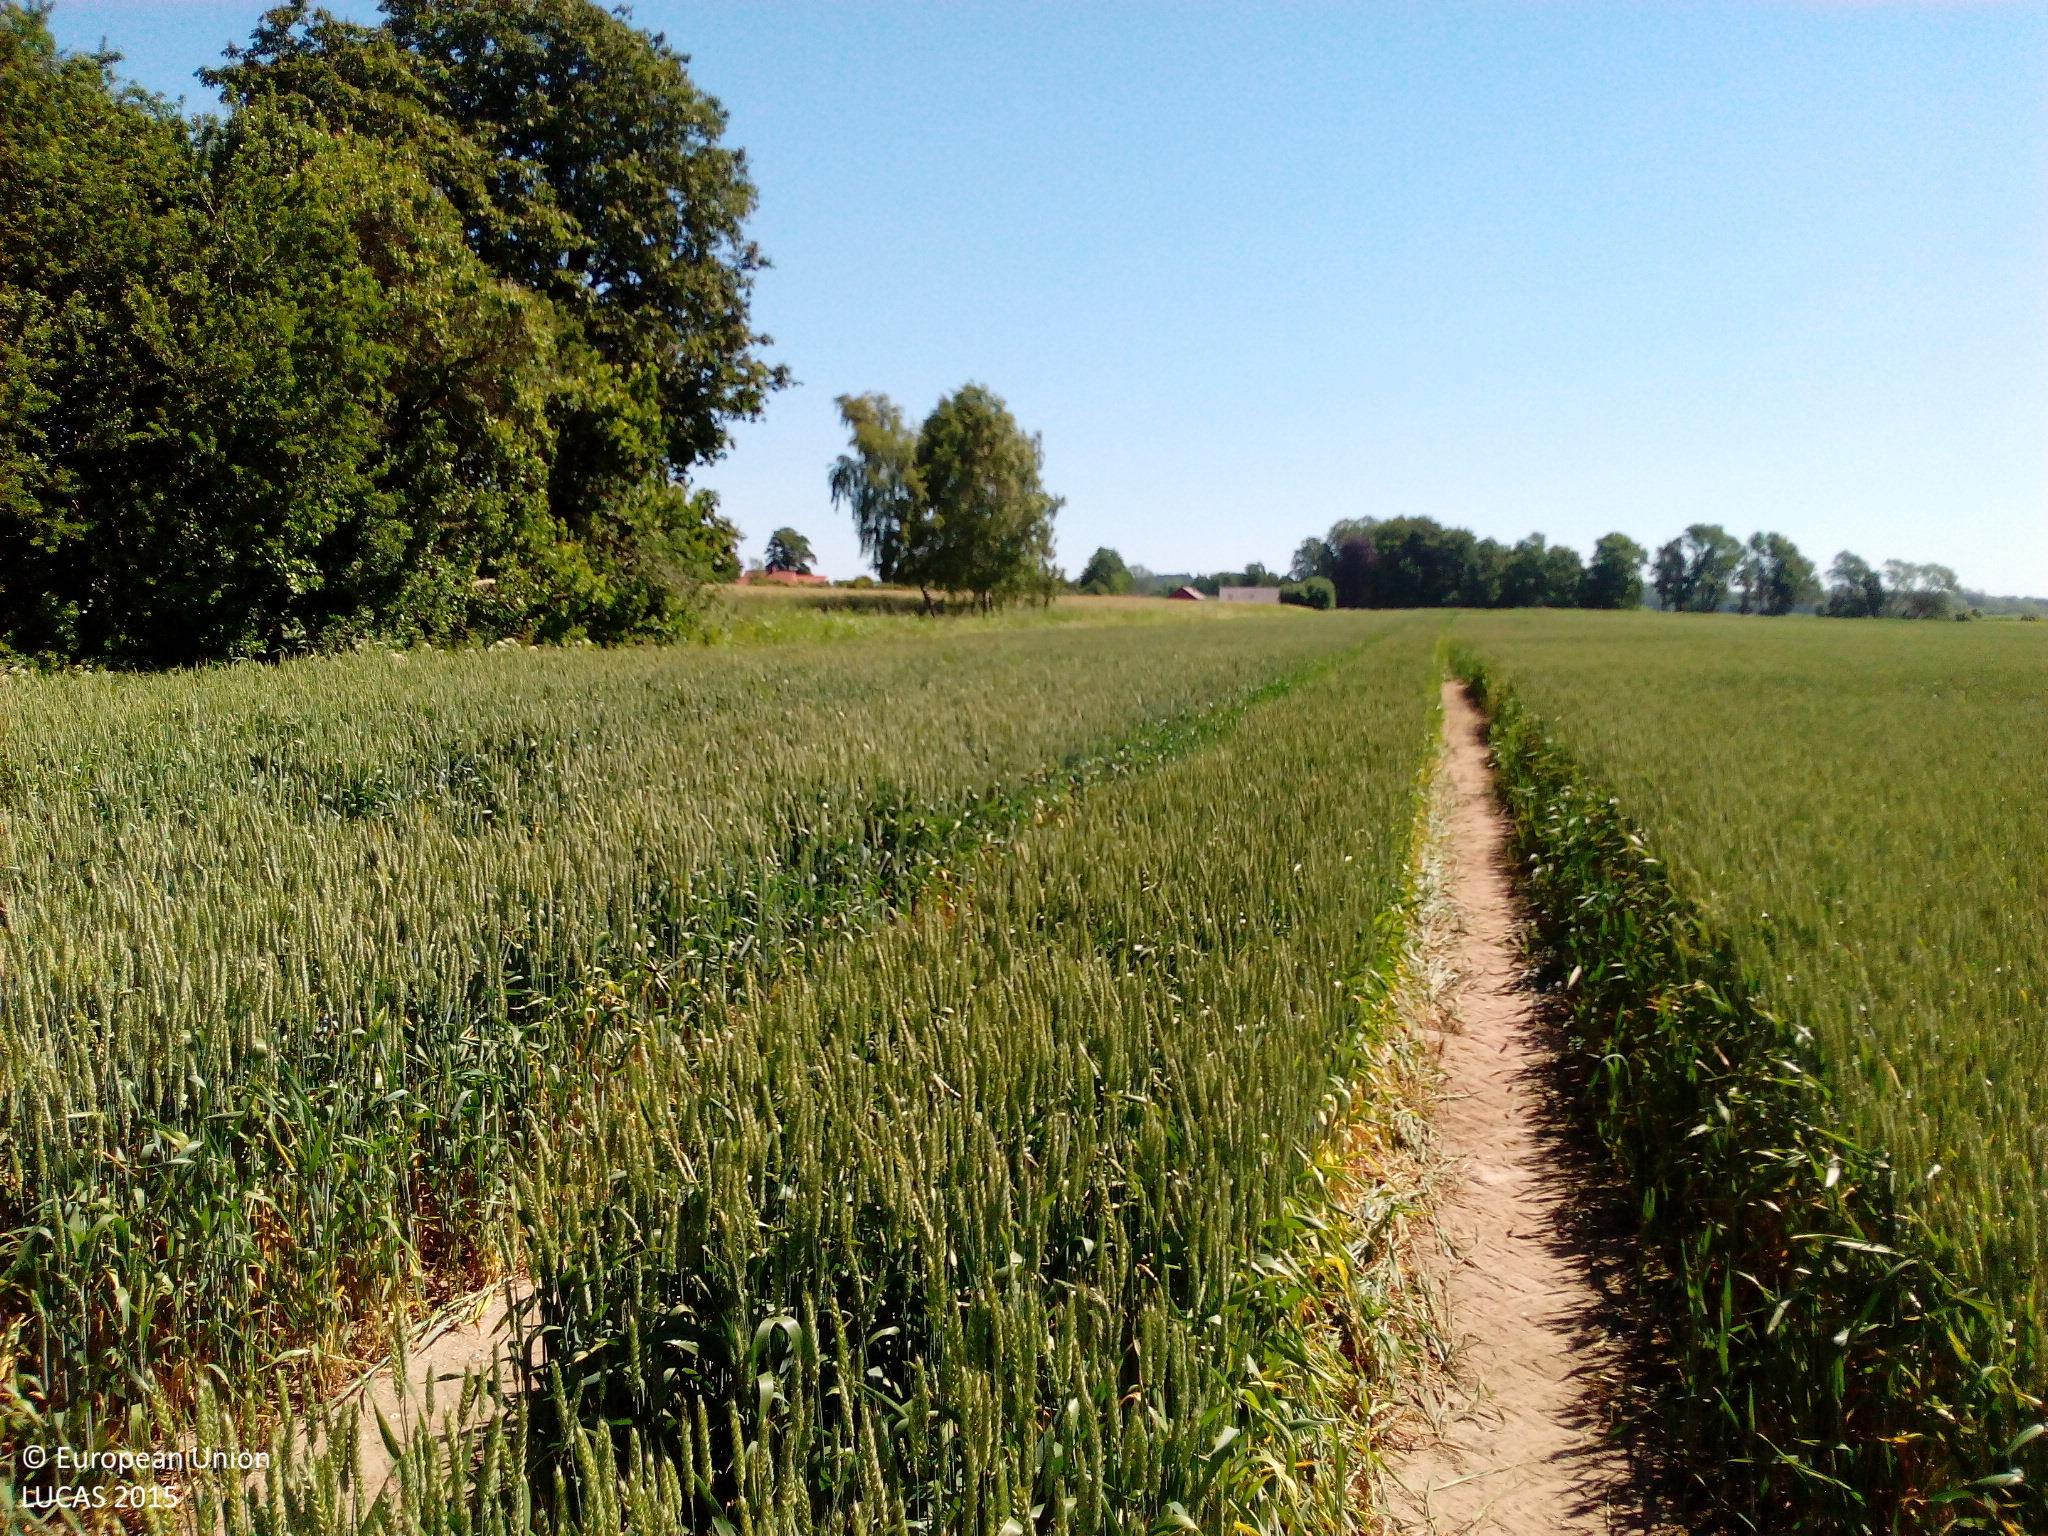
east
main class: Cropland
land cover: Common wheat
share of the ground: > 75 %
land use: Agriculture (excluding fallow land and kitchen gardens)
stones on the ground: 10 - 25 %
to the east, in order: Common wheat; Grass margins; Ditches and canals; Grassland without tree/shrub cover; Rye; Grassland without tree/shrub cover
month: July
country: DK
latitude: 56.3838
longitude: 10.6632
